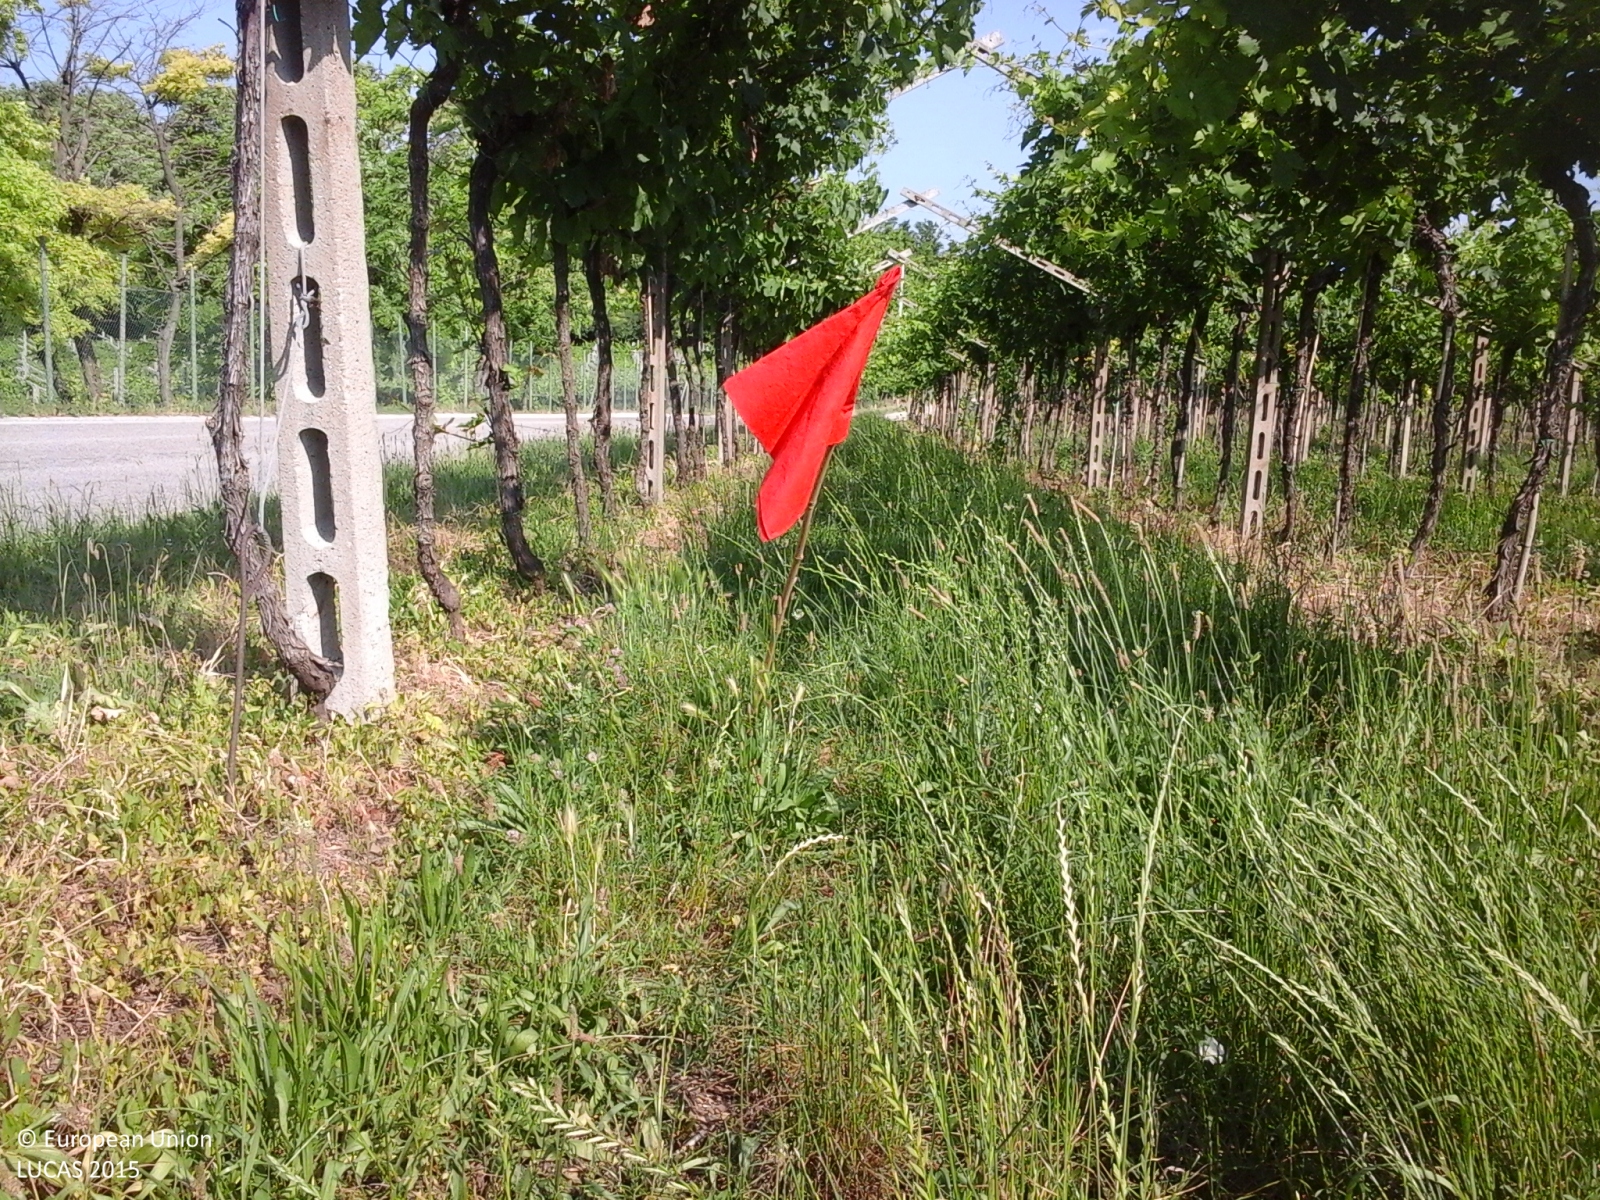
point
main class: Cropland
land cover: Vineyards
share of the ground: > 75 %
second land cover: Grassland without tree/shrub cover
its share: > 75 %
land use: Agriculture (excluding fallow land and kitchen gardens)
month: June
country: IT
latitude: 45.5378
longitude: 10.7543
